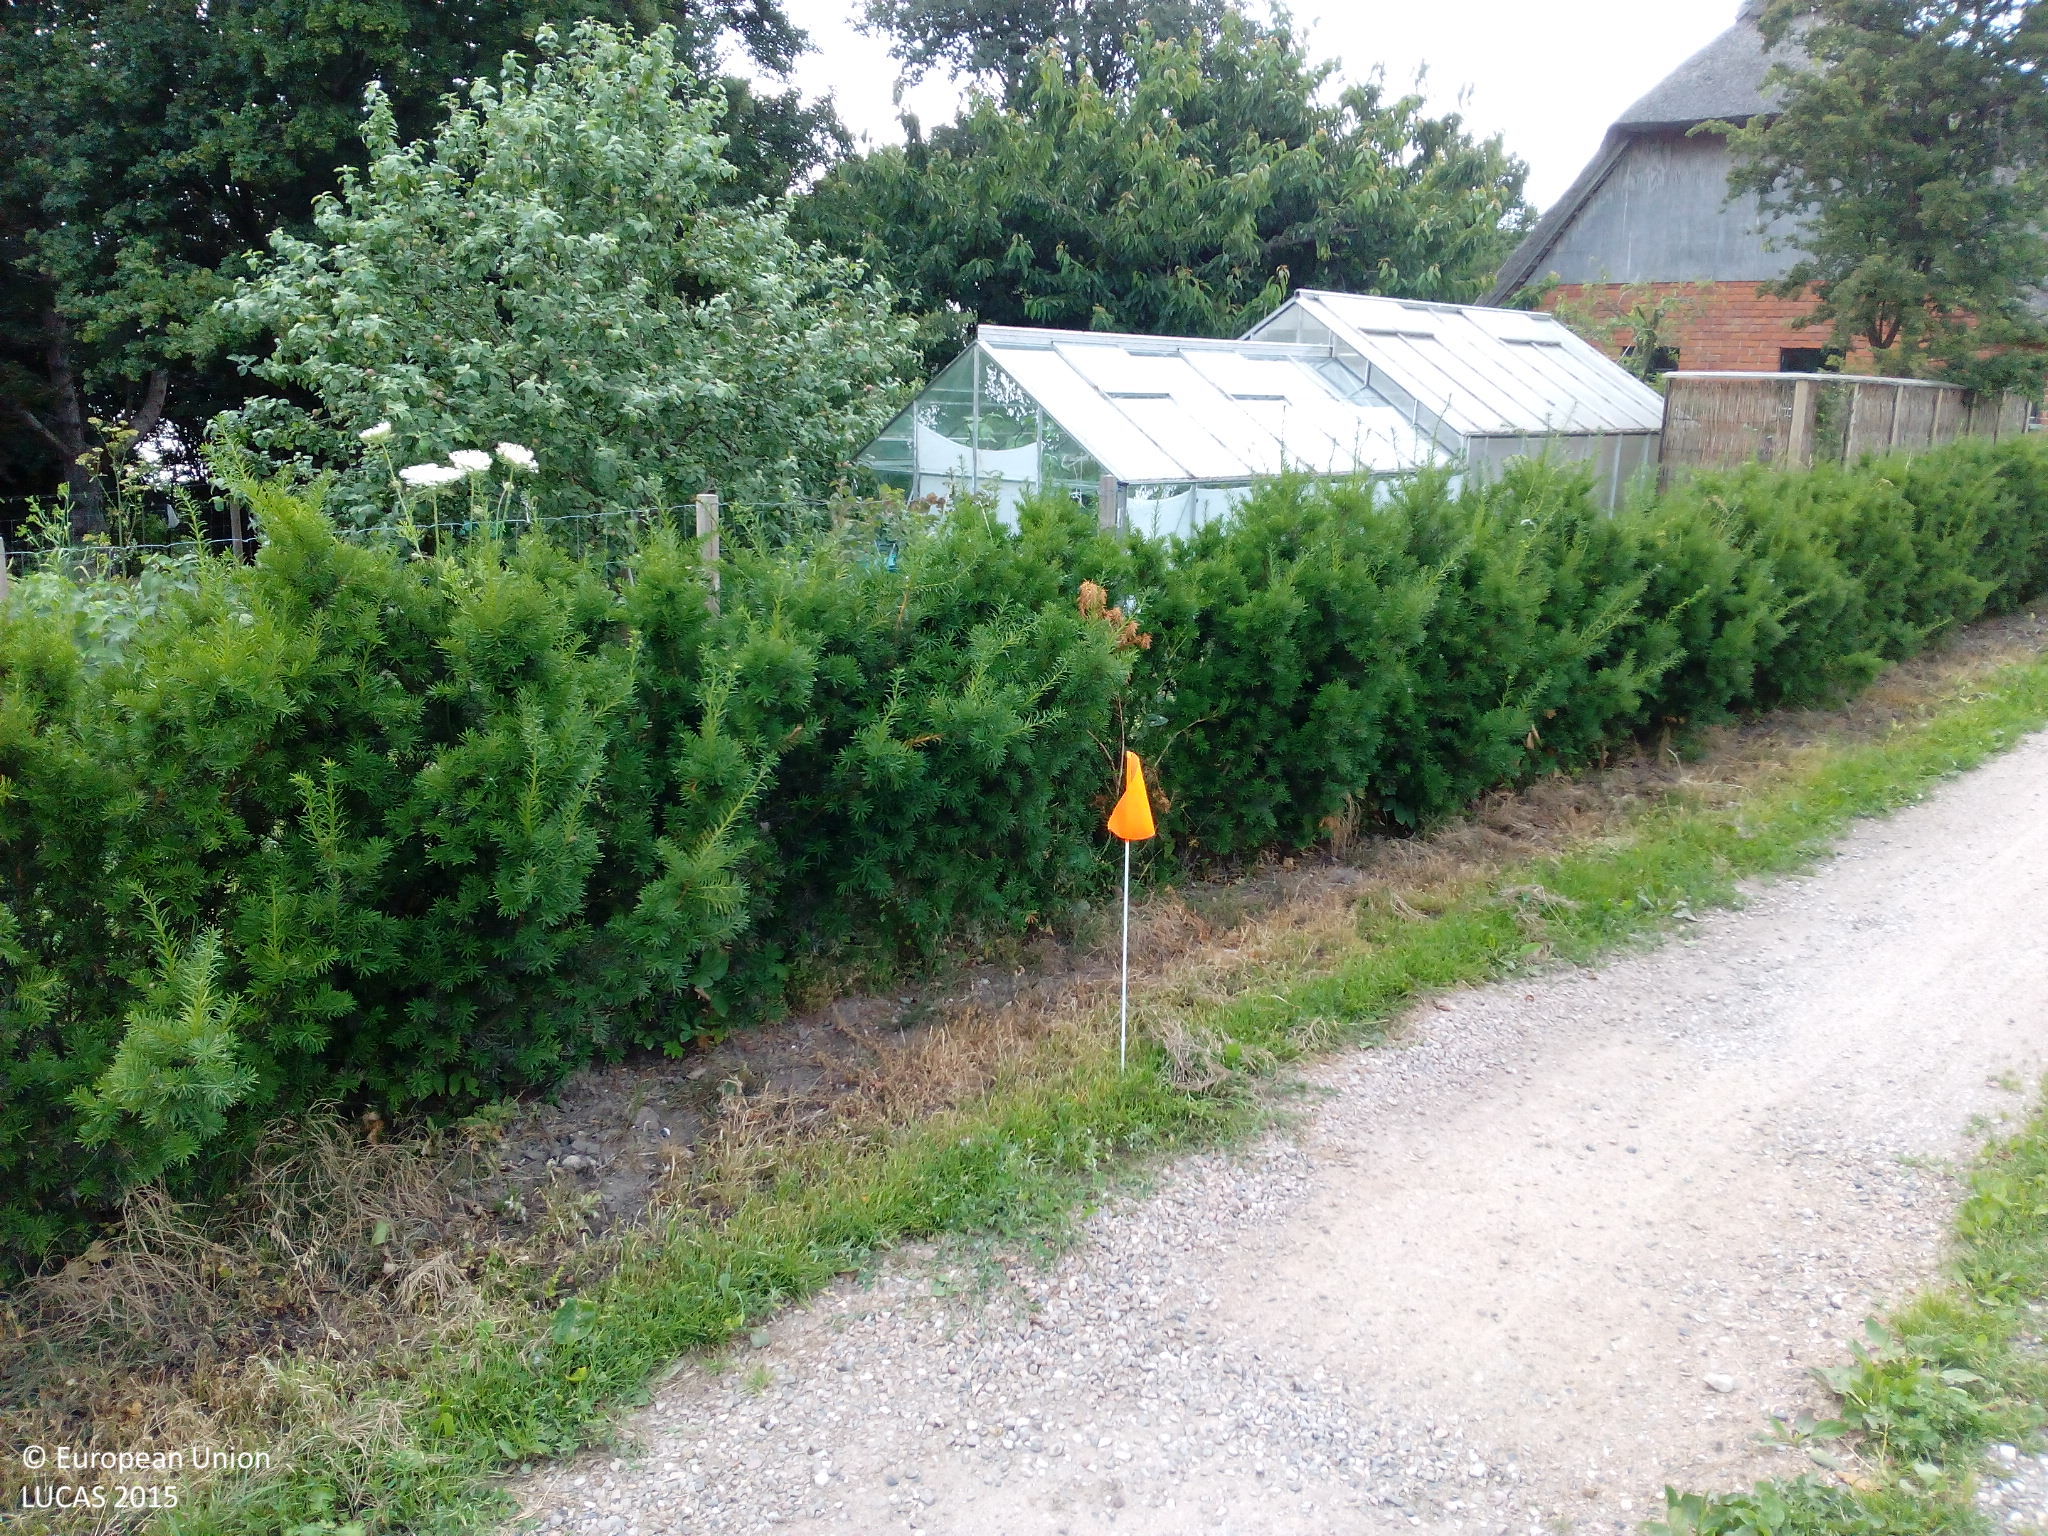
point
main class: Cropland
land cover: Rape and turnip rape
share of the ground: > 75 %
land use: Agriculture (excluding fallow land and kitchen gardens)
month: July
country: DK
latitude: 55.7787
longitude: 11.8637
